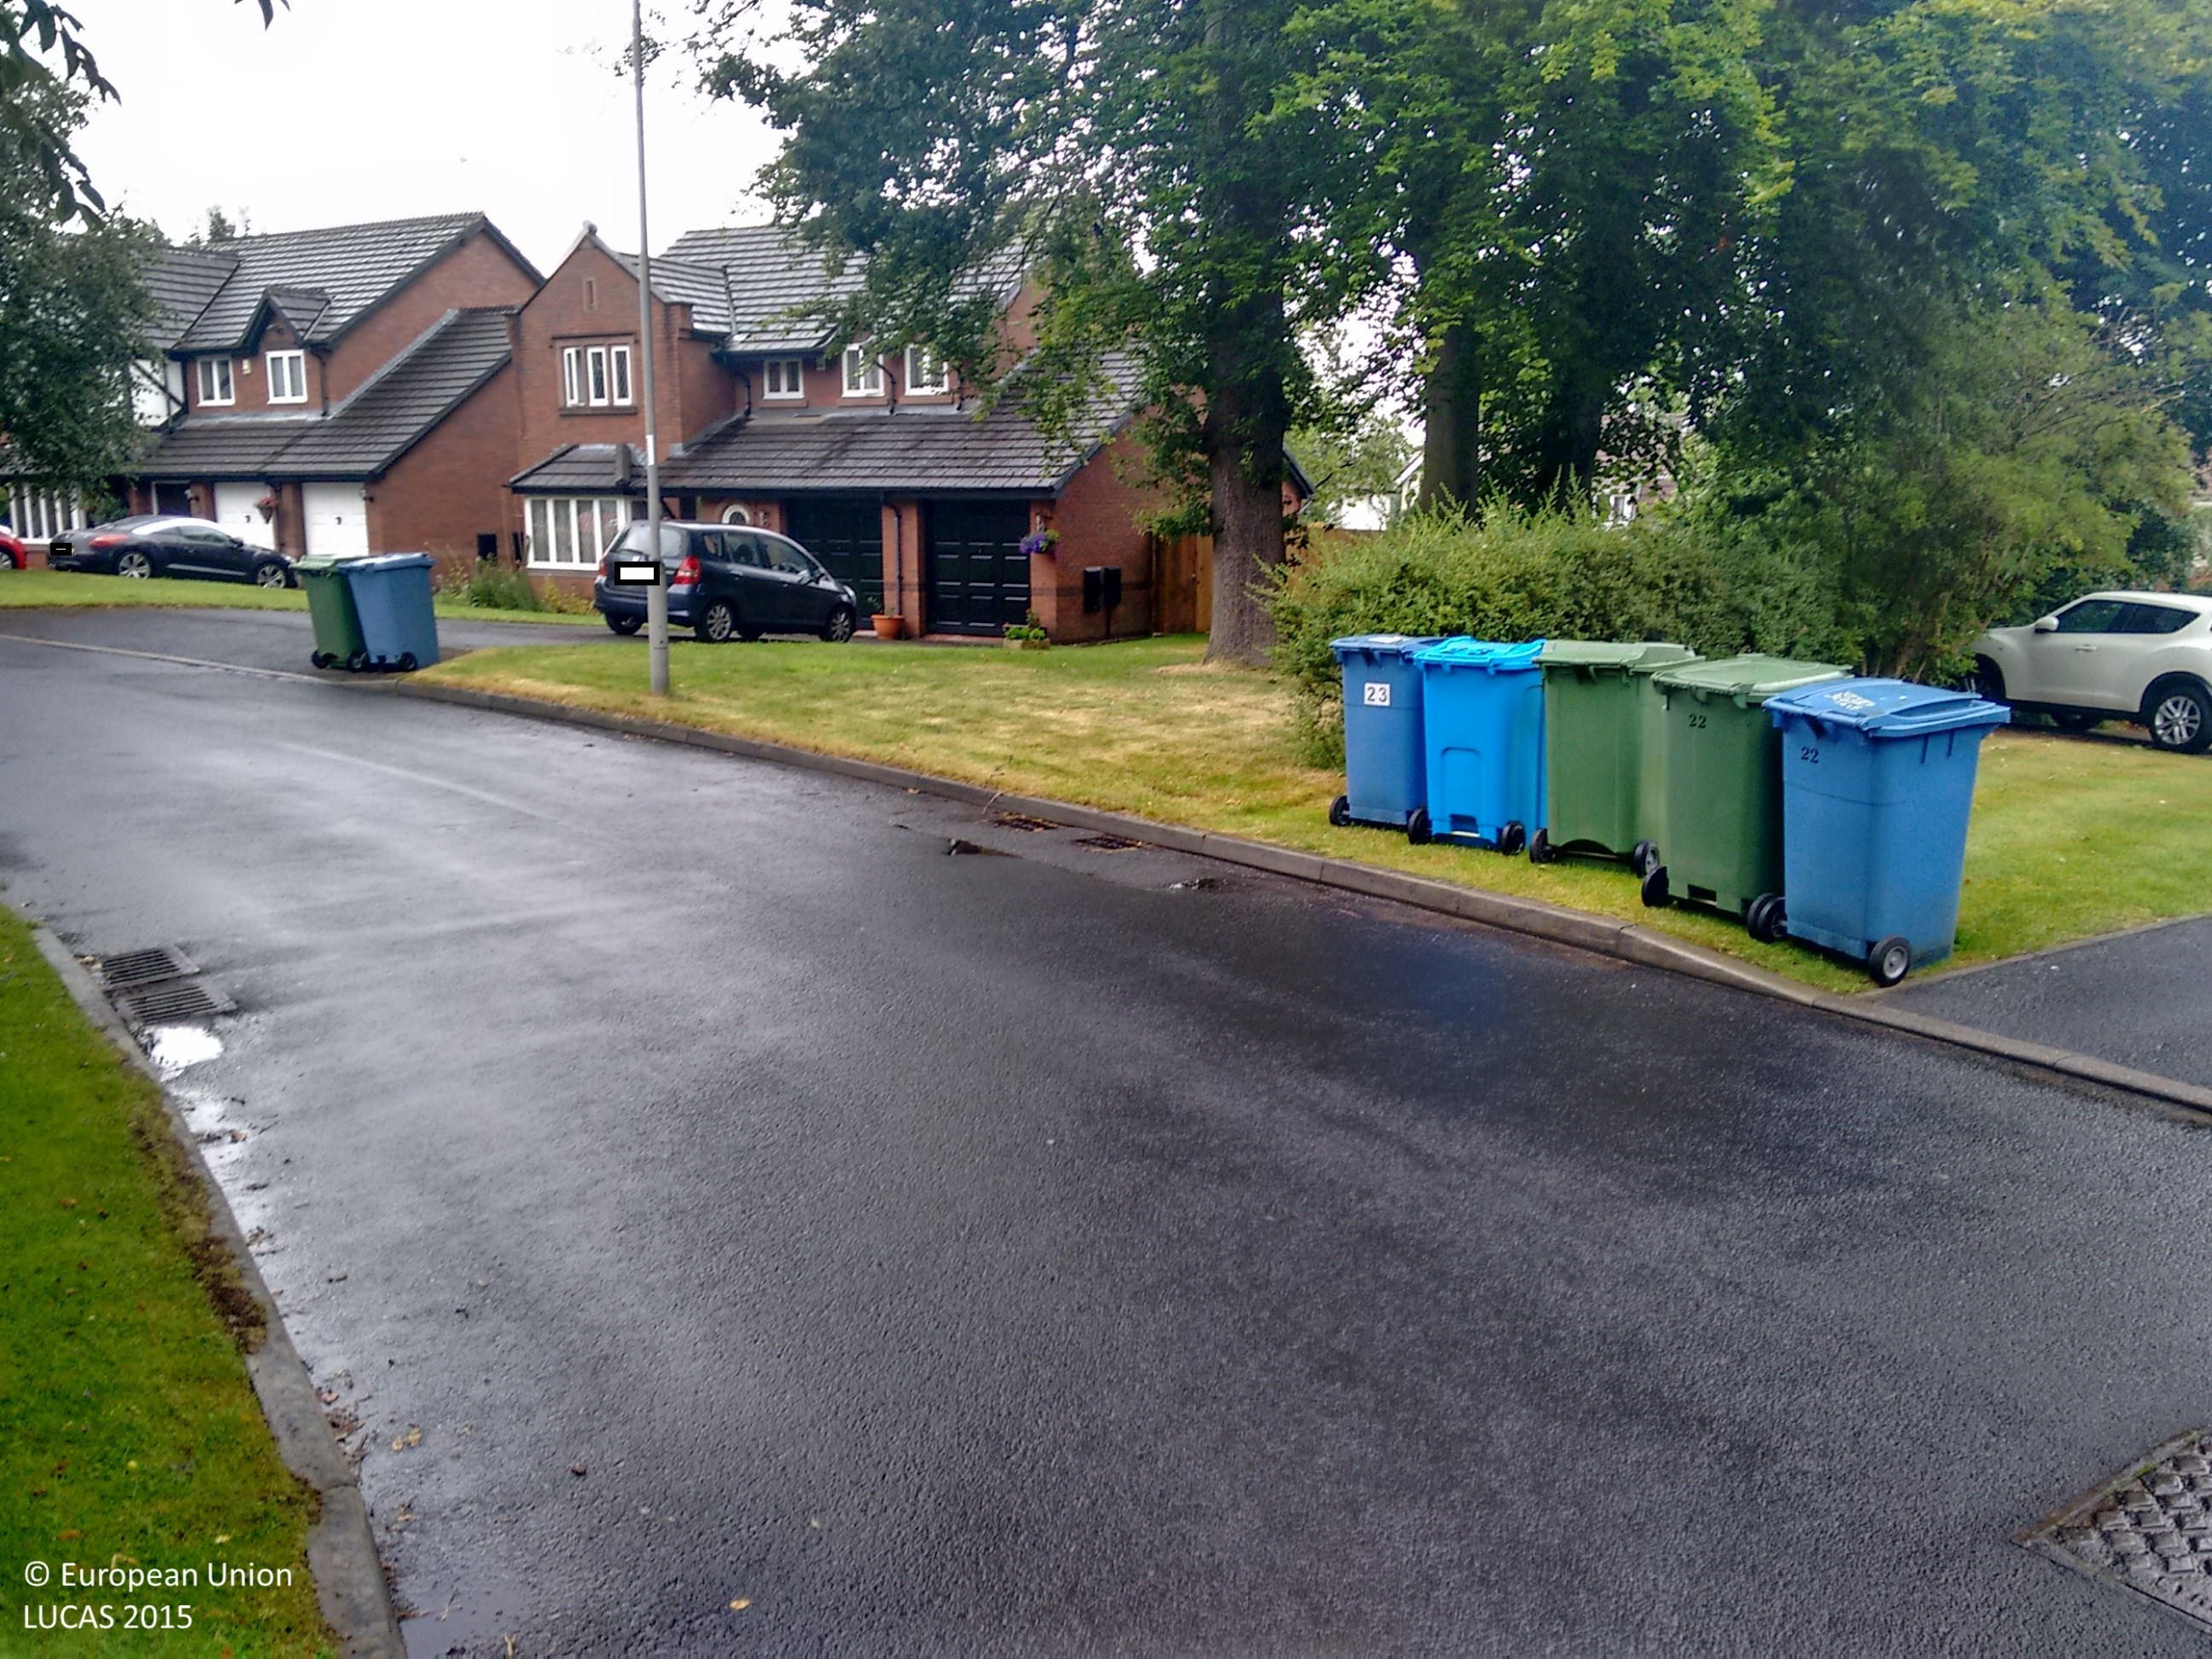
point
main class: Woodland
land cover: Broadleaved woodland
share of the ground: > 75 %
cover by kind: broadleaved forest trees 100 %
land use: Residential
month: July
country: GB
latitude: 53.3859
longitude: -2.8668
